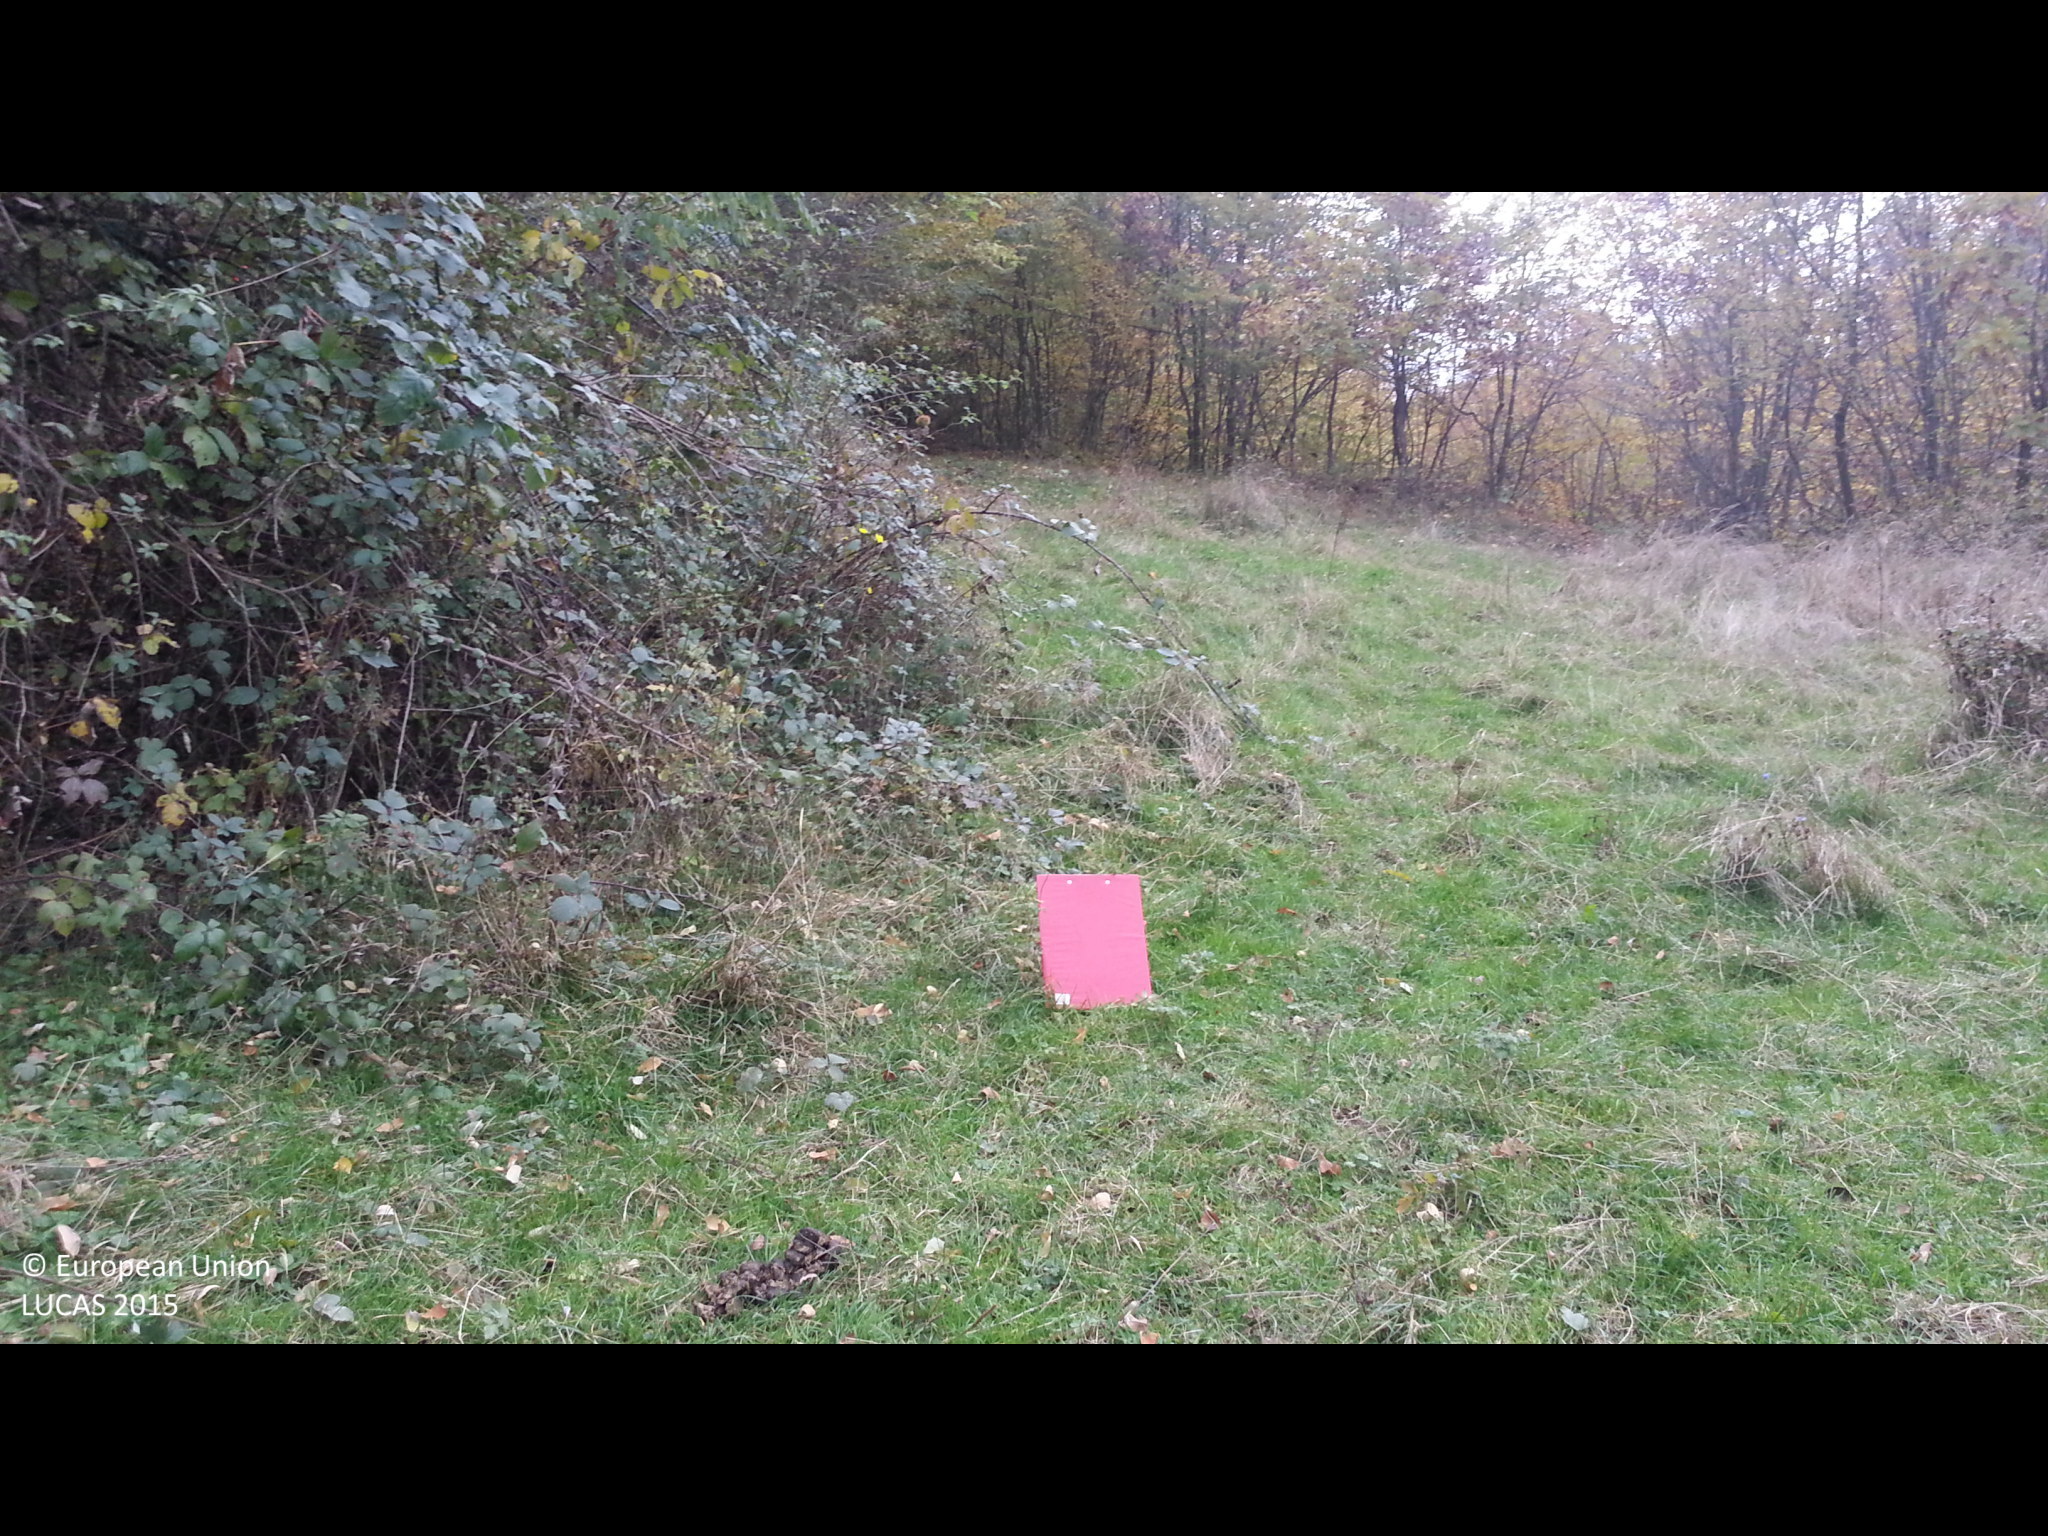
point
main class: Grassland
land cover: Grassland with sparse tree/shrub cover
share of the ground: > 75 %
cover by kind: herbaceous plants 90 %, broadleaved forest trees 5 %, shrubs 5 %
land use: Agriculture (excluding fallow land and kitchen gardens)
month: October
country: BG
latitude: 42.9490
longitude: 23.6589
